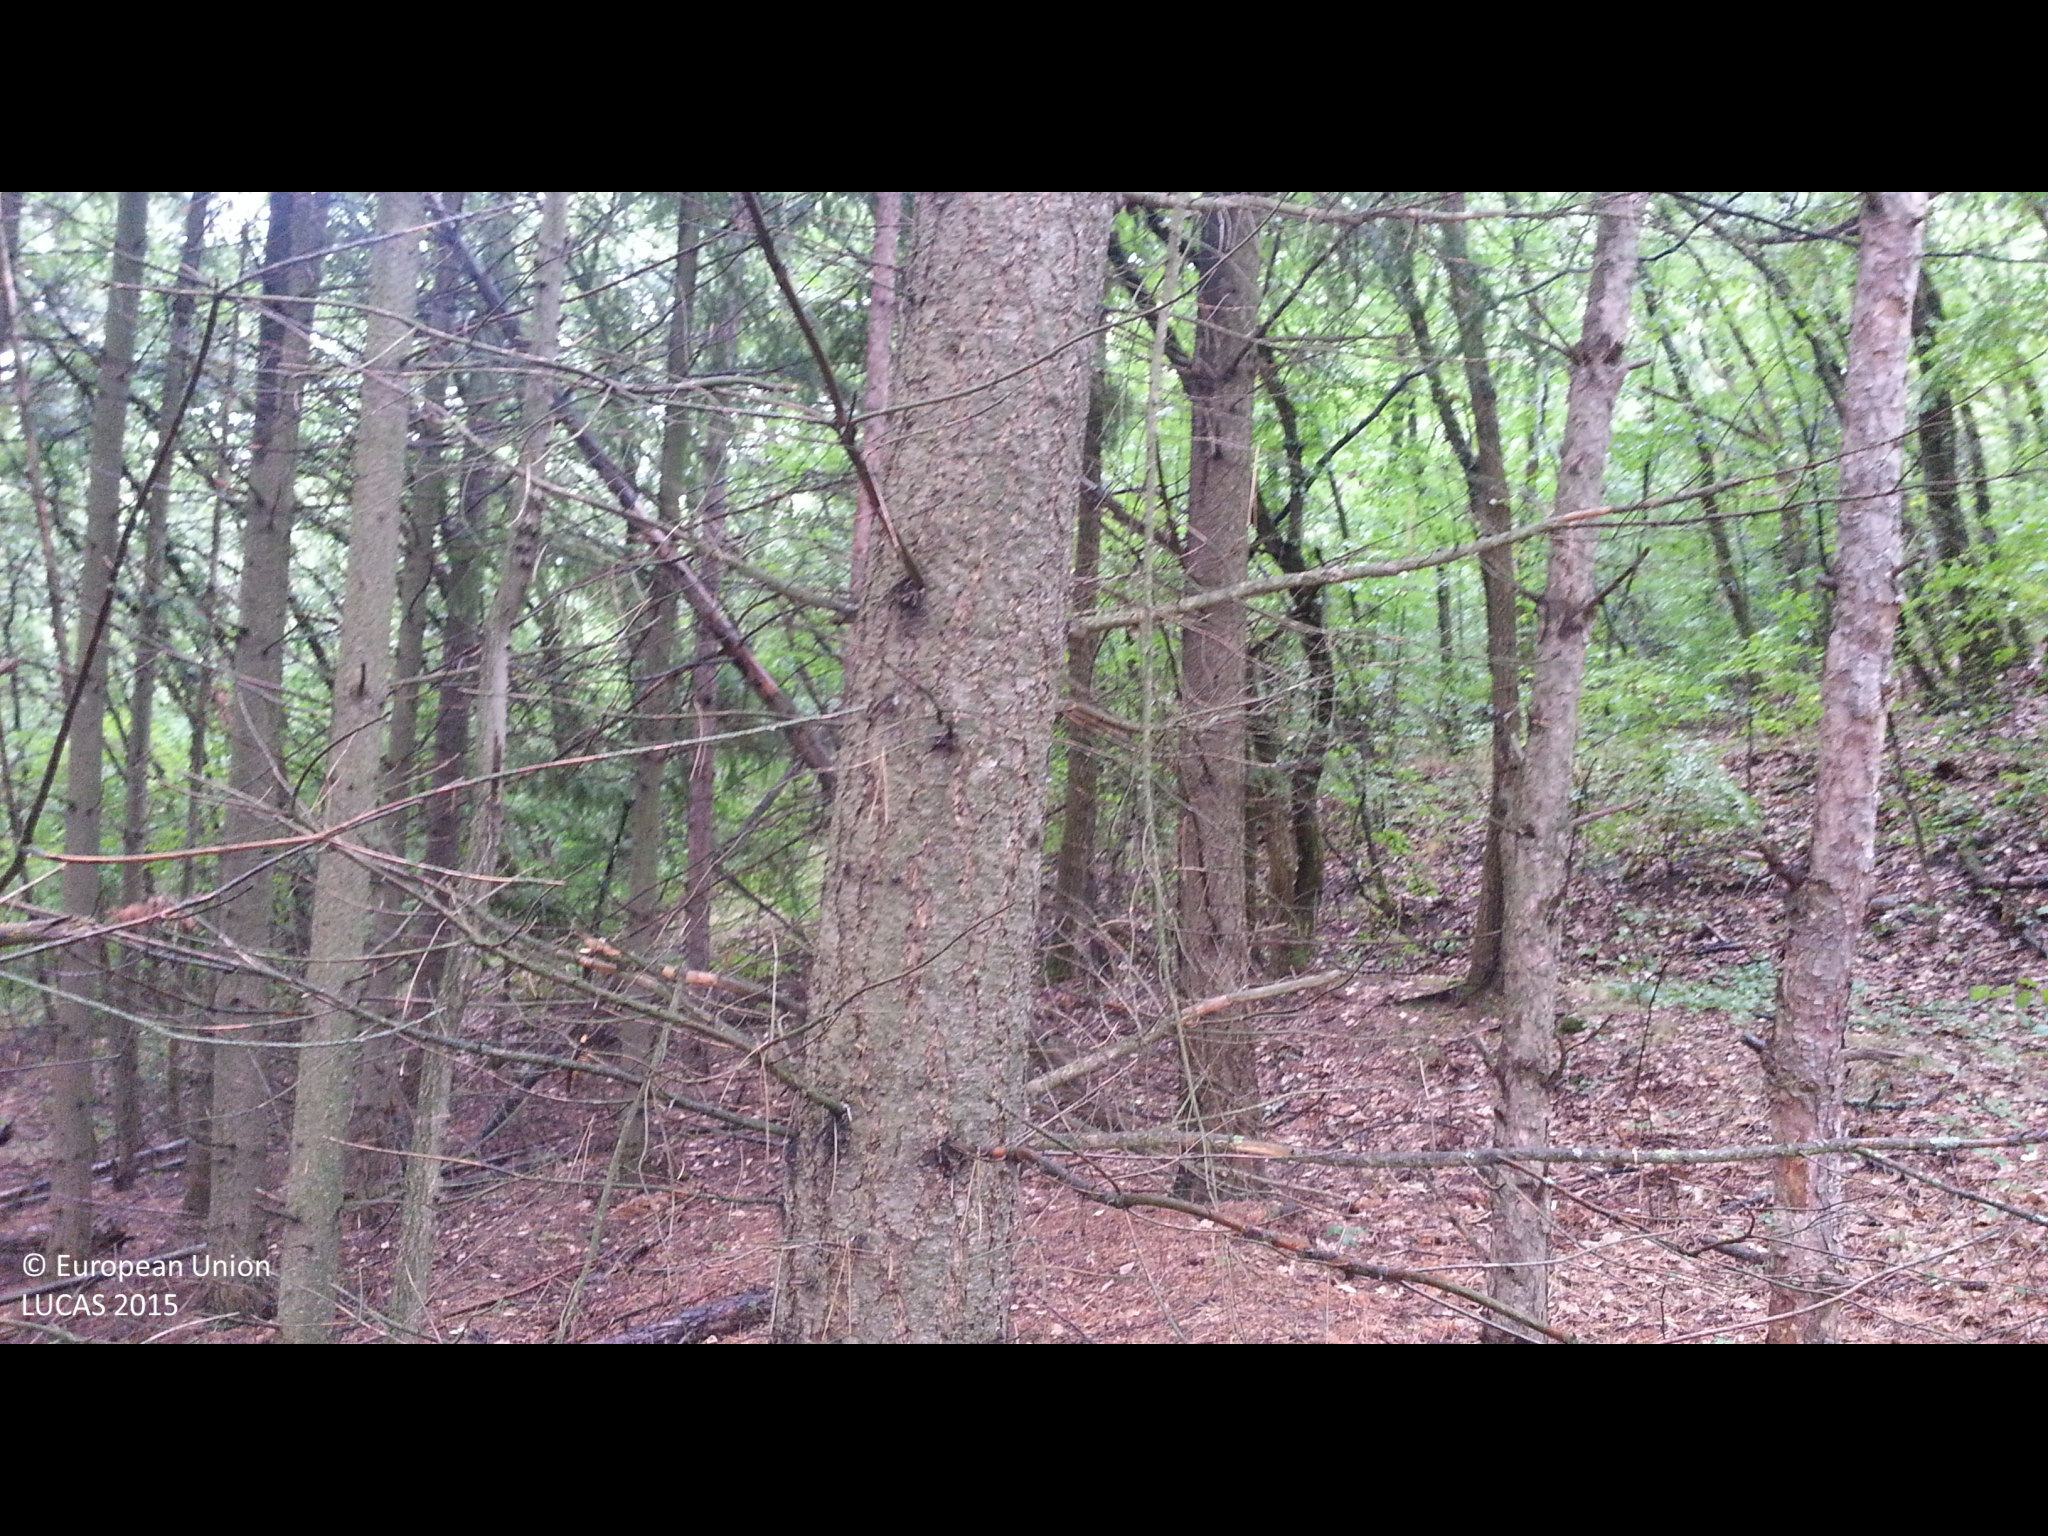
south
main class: Woodland
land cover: Pine dominated coniferous woodland
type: hemiboreal forest and nemoral coniferous forest and mixed broadleaved-coniferous forest
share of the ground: > 75 %
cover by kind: coniferous forest trees 95 %, shrubs 5 %
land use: Forestry
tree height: > 5 m
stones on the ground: < 10 %
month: August
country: BG
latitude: 42.2739
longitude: 22.9624
